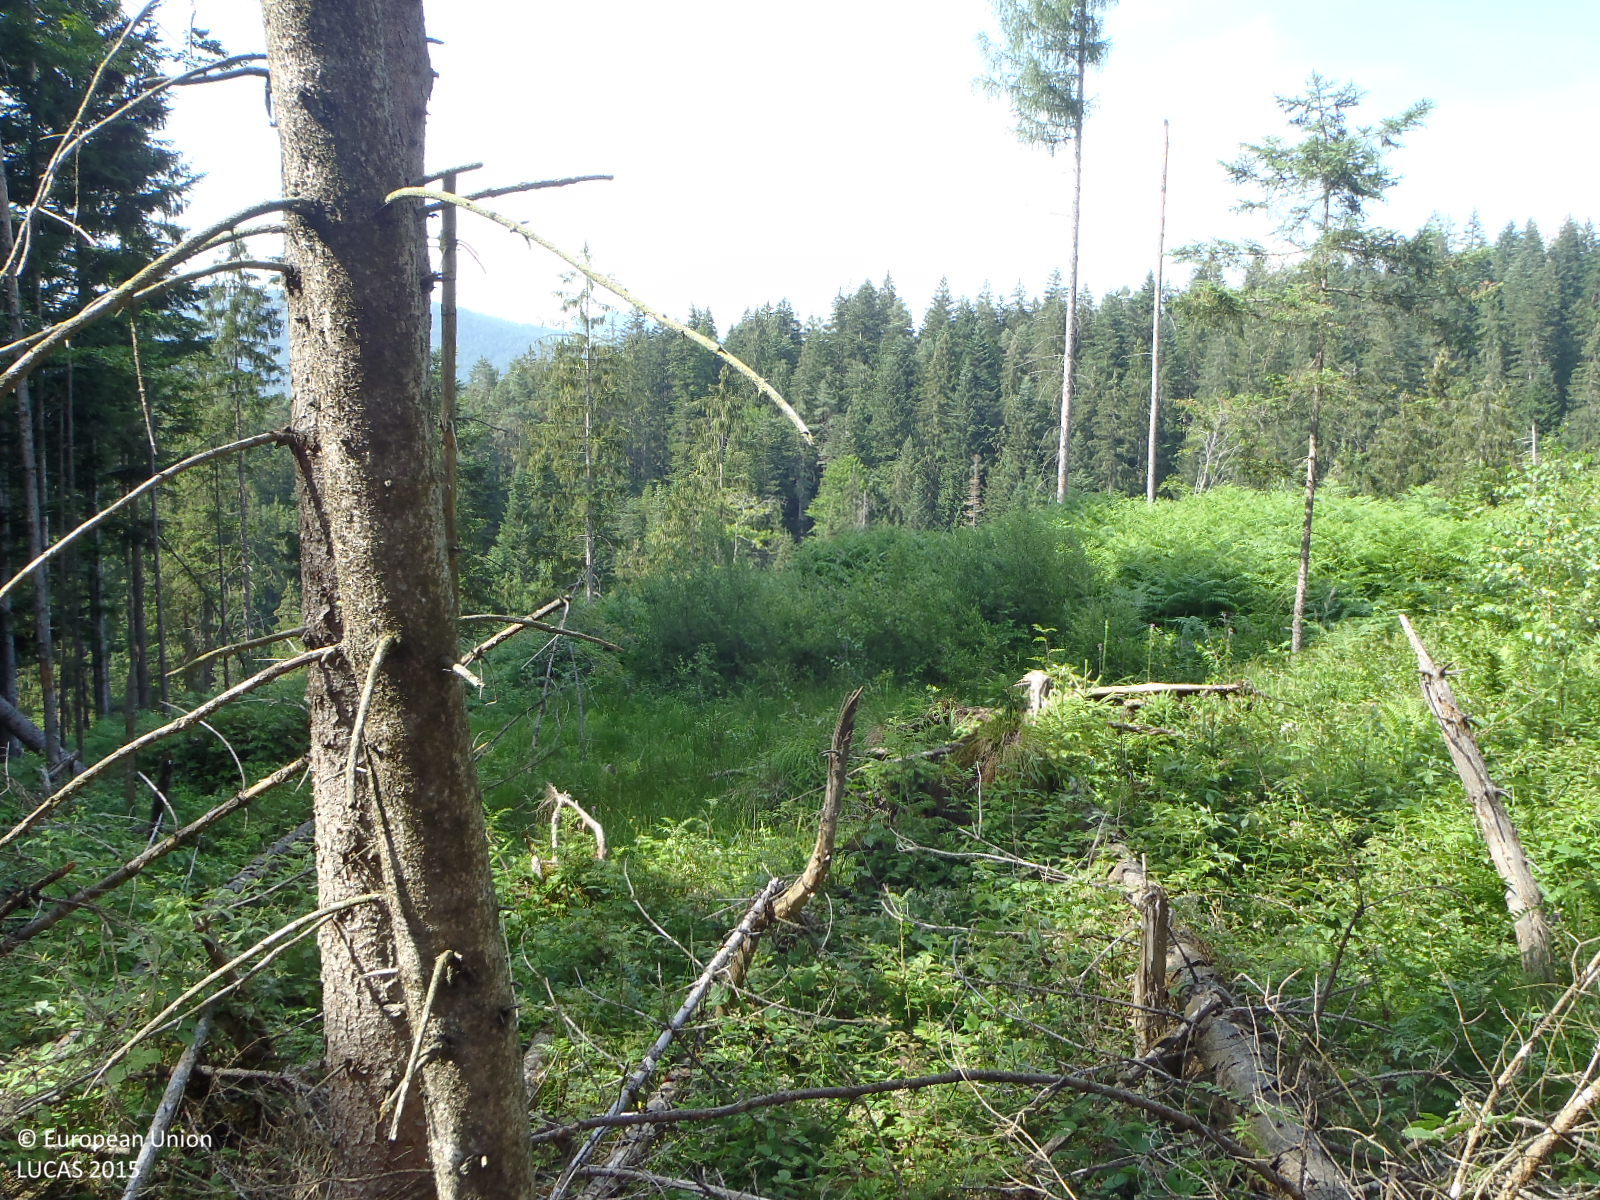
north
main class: Woodland
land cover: Spruce dominated coniferous woodland
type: alpine coniferous forest
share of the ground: 50 - 75 %
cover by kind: coniferous forest trees 60 %, herbaceous plants 20 %, shrubs 10 %, broadleaved forest trees 5 %, lichens and mosses 5 %
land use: Forestry
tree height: > 5 m
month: July
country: AT
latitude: 47.5300
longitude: 12.4557
